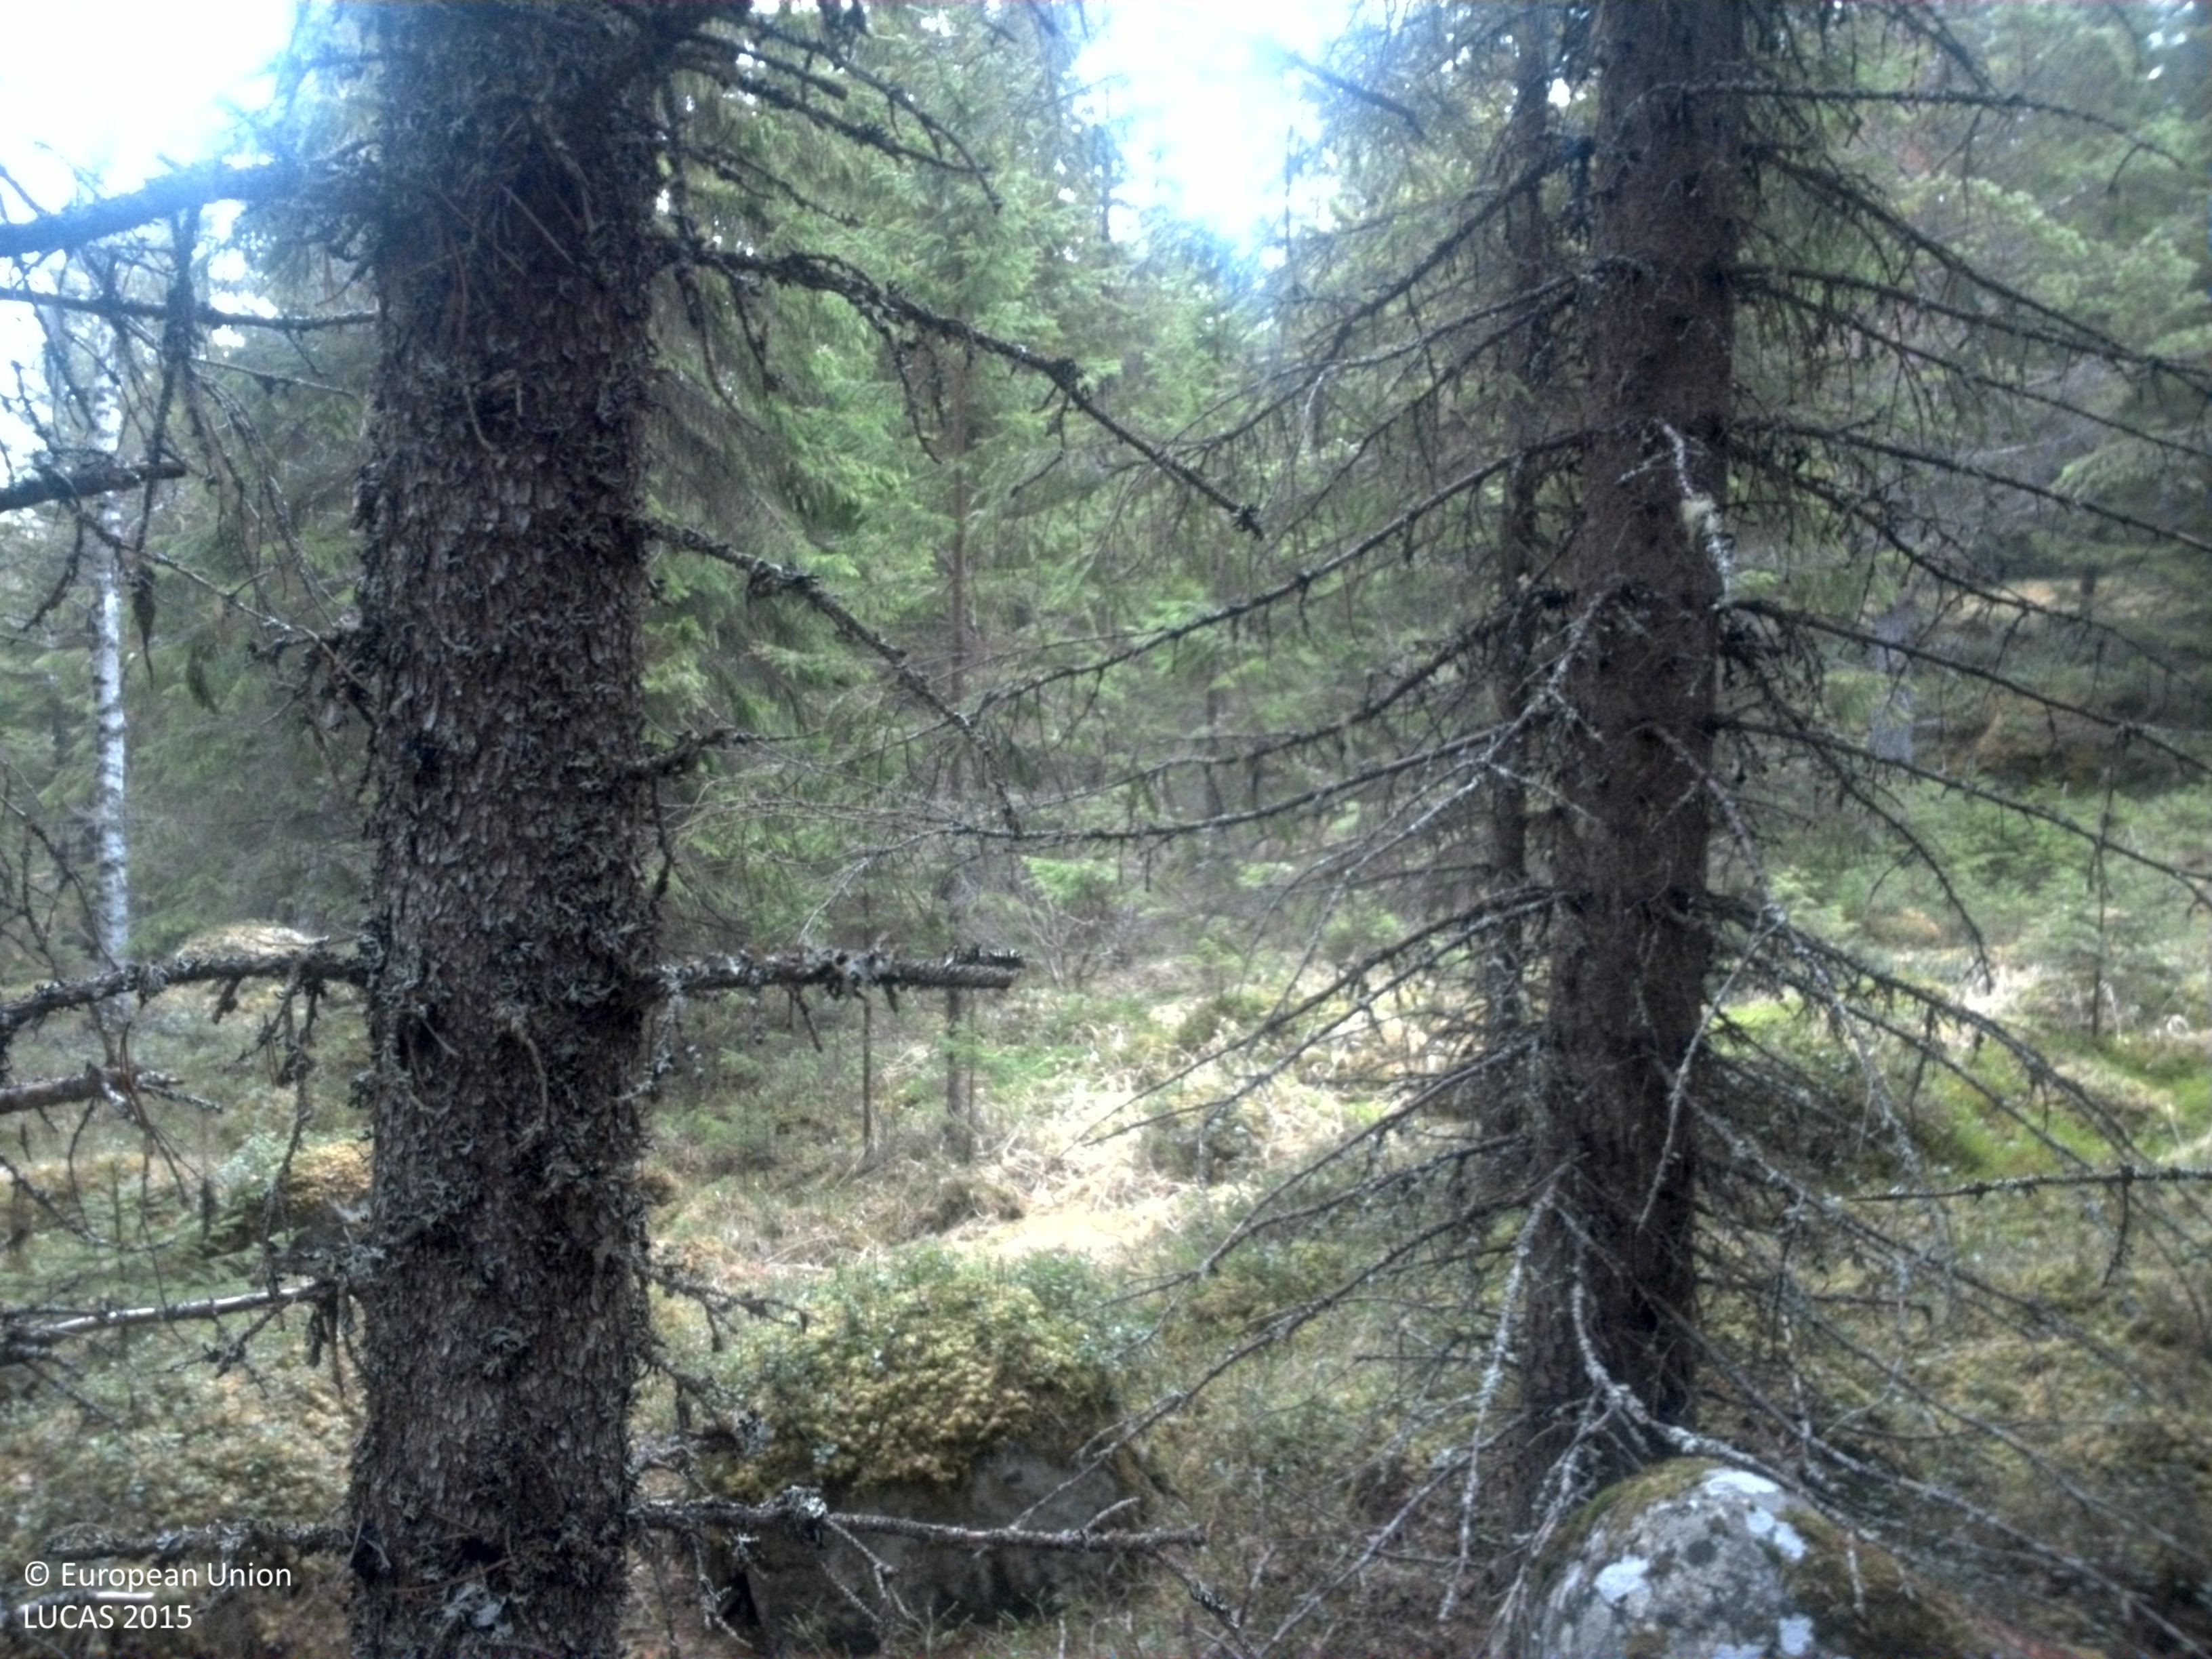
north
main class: Woodland
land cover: Spruce dominated coniferous woodland
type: boreal forest
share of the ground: > 75 %
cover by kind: coniferous forest trees 80 %, lichens and mosses 20 %
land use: Forestry
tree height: > 5 m
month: May
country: SE
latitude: 62.7060
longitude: 15.1204
